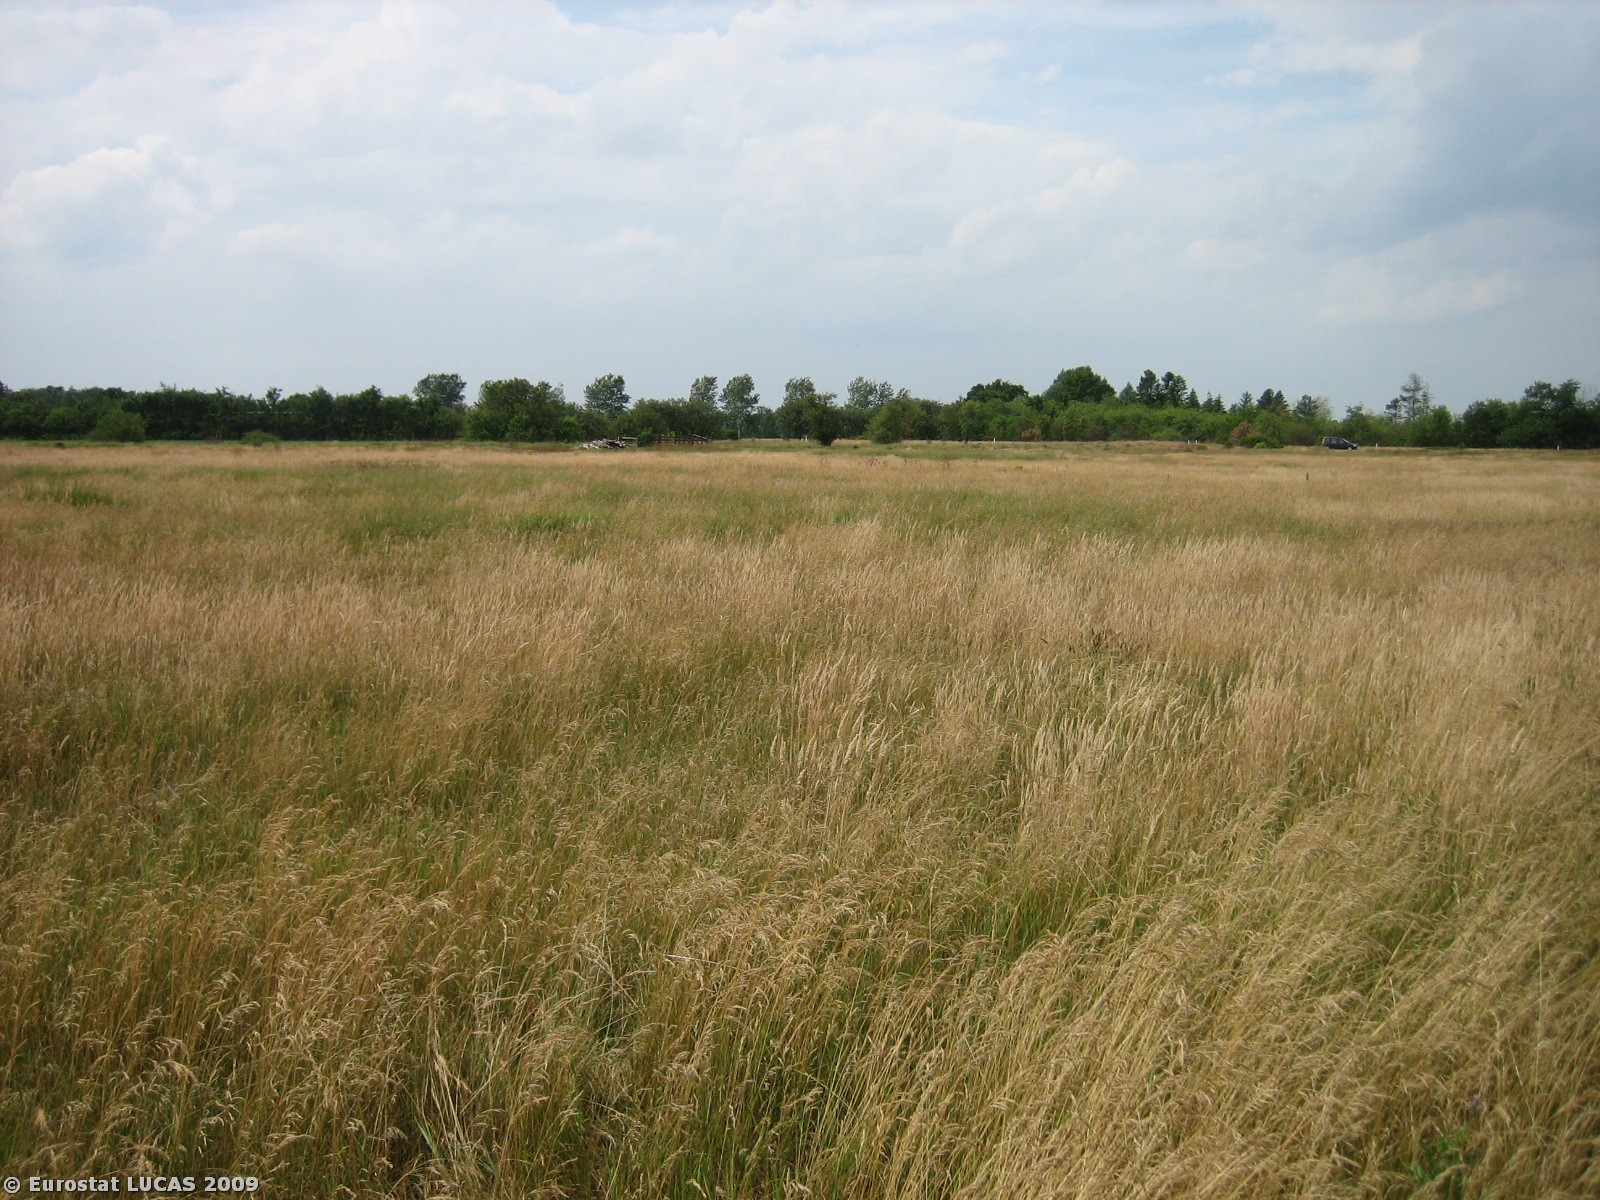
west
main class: Grassland
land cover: Grassland without tree/shrub cover
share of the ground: > 75 %
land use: Fallow land
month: July
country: DK
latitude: 55.8945
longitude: 8.8019
